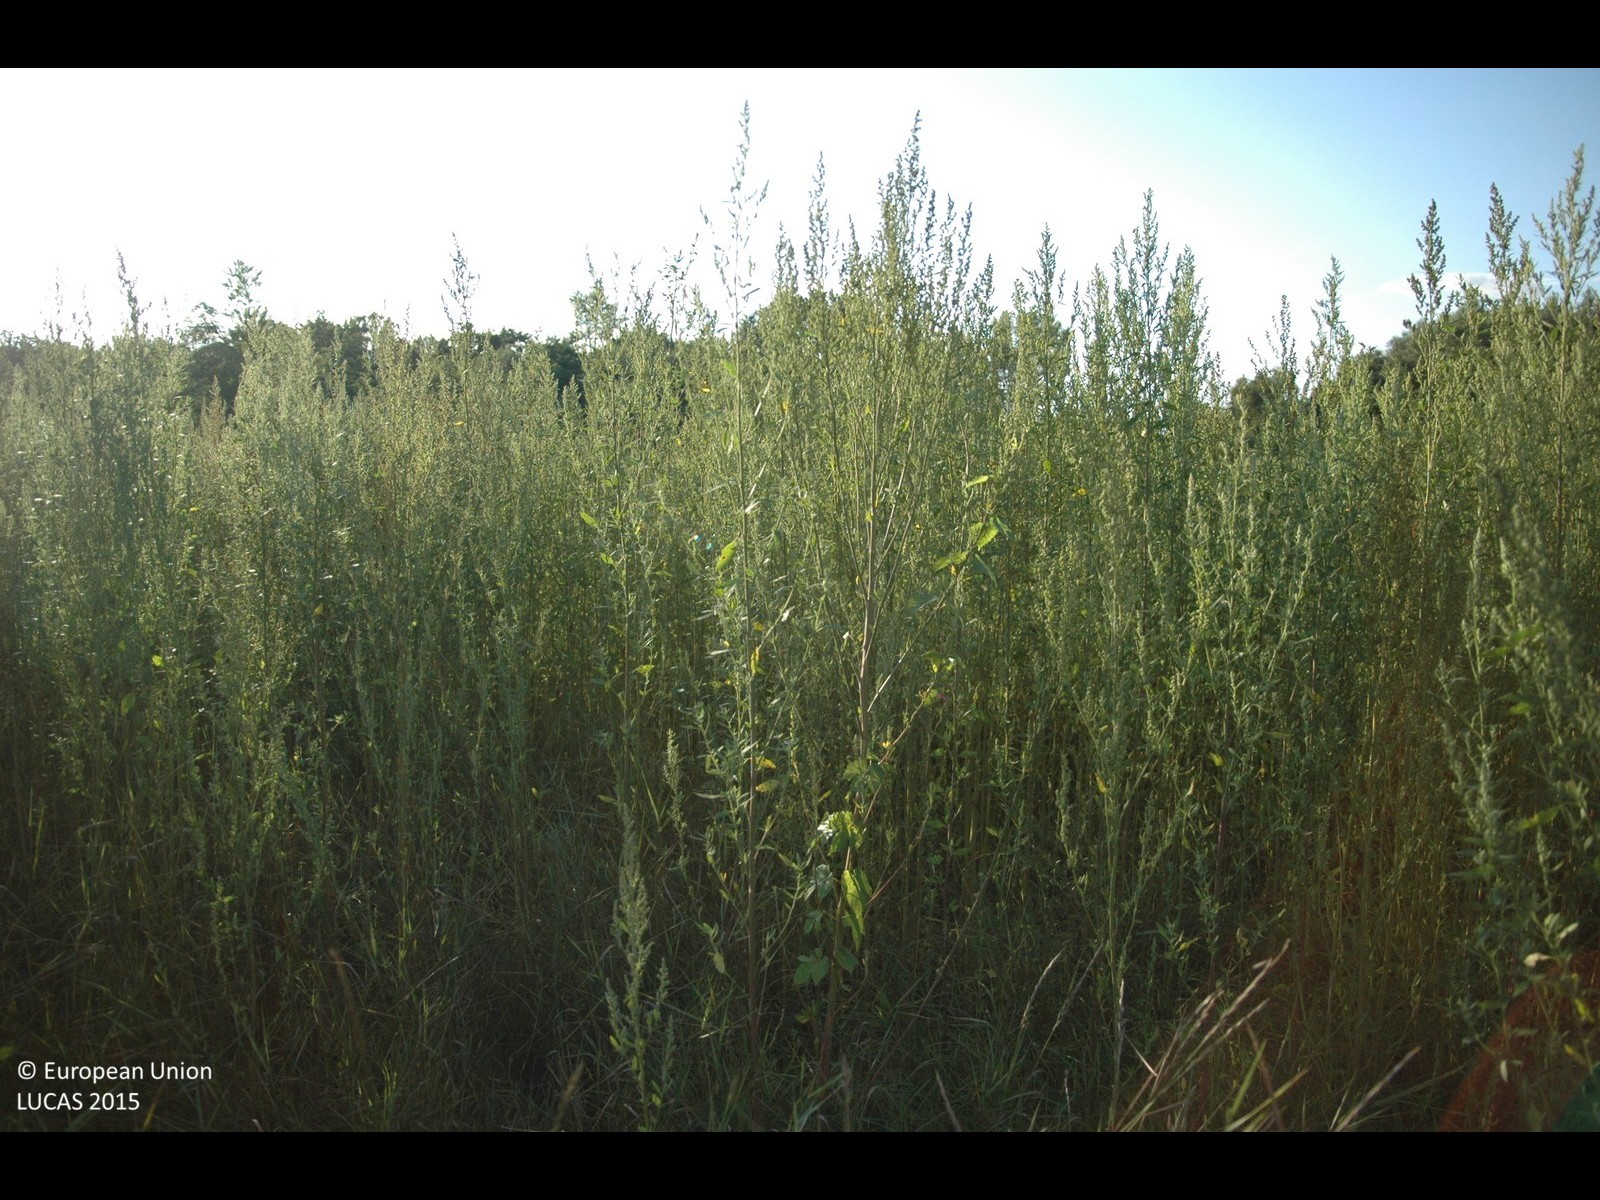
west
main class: Grassland
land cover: Grassland without tree/shrub cover
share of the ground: > 75 %
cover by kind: herbaceous plants 100 %
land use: Abandoned areas
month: July
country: HR
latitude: 46.2604
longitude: 16.8125
